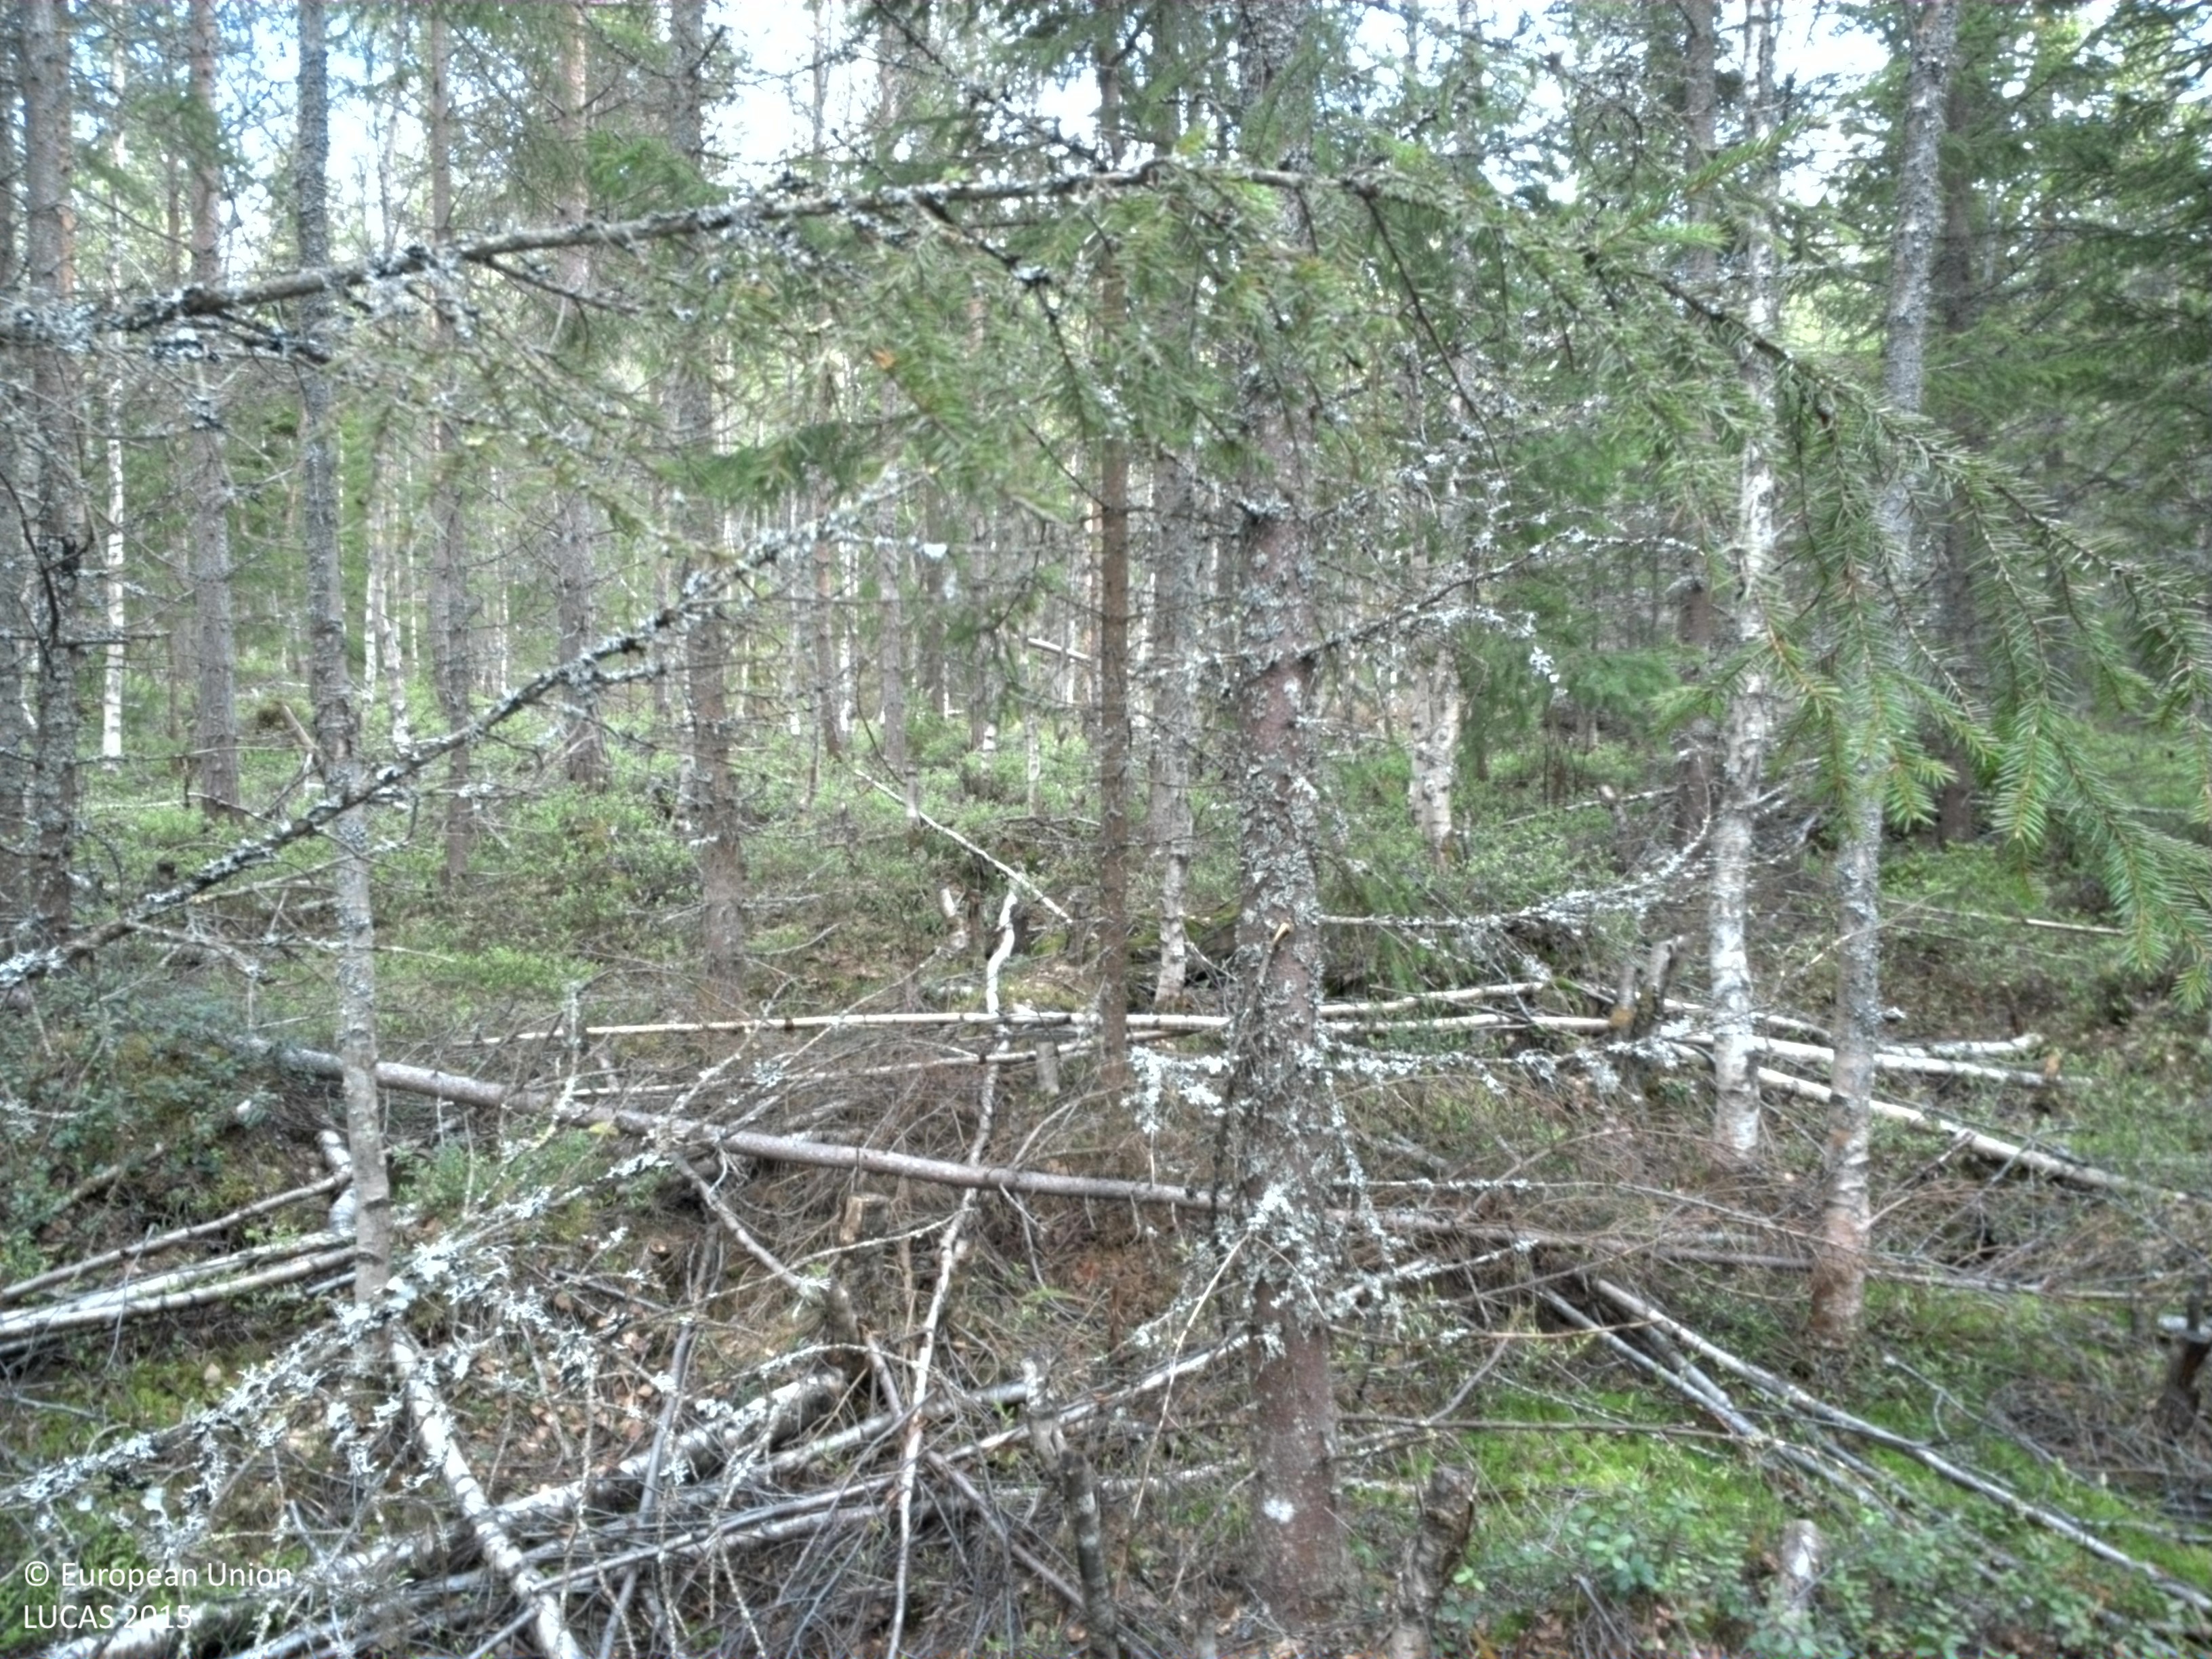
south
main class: Woodland
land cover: Other mixed woodland
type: boreal forest
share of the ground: > 75 %
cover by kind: coniferous forest trees 55 %, broadleaved forest trees 30 %, shrubs 15 %
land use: Forestry
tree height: > 5 m
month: May
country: SE
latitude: 60.3735
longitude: 13.4177
